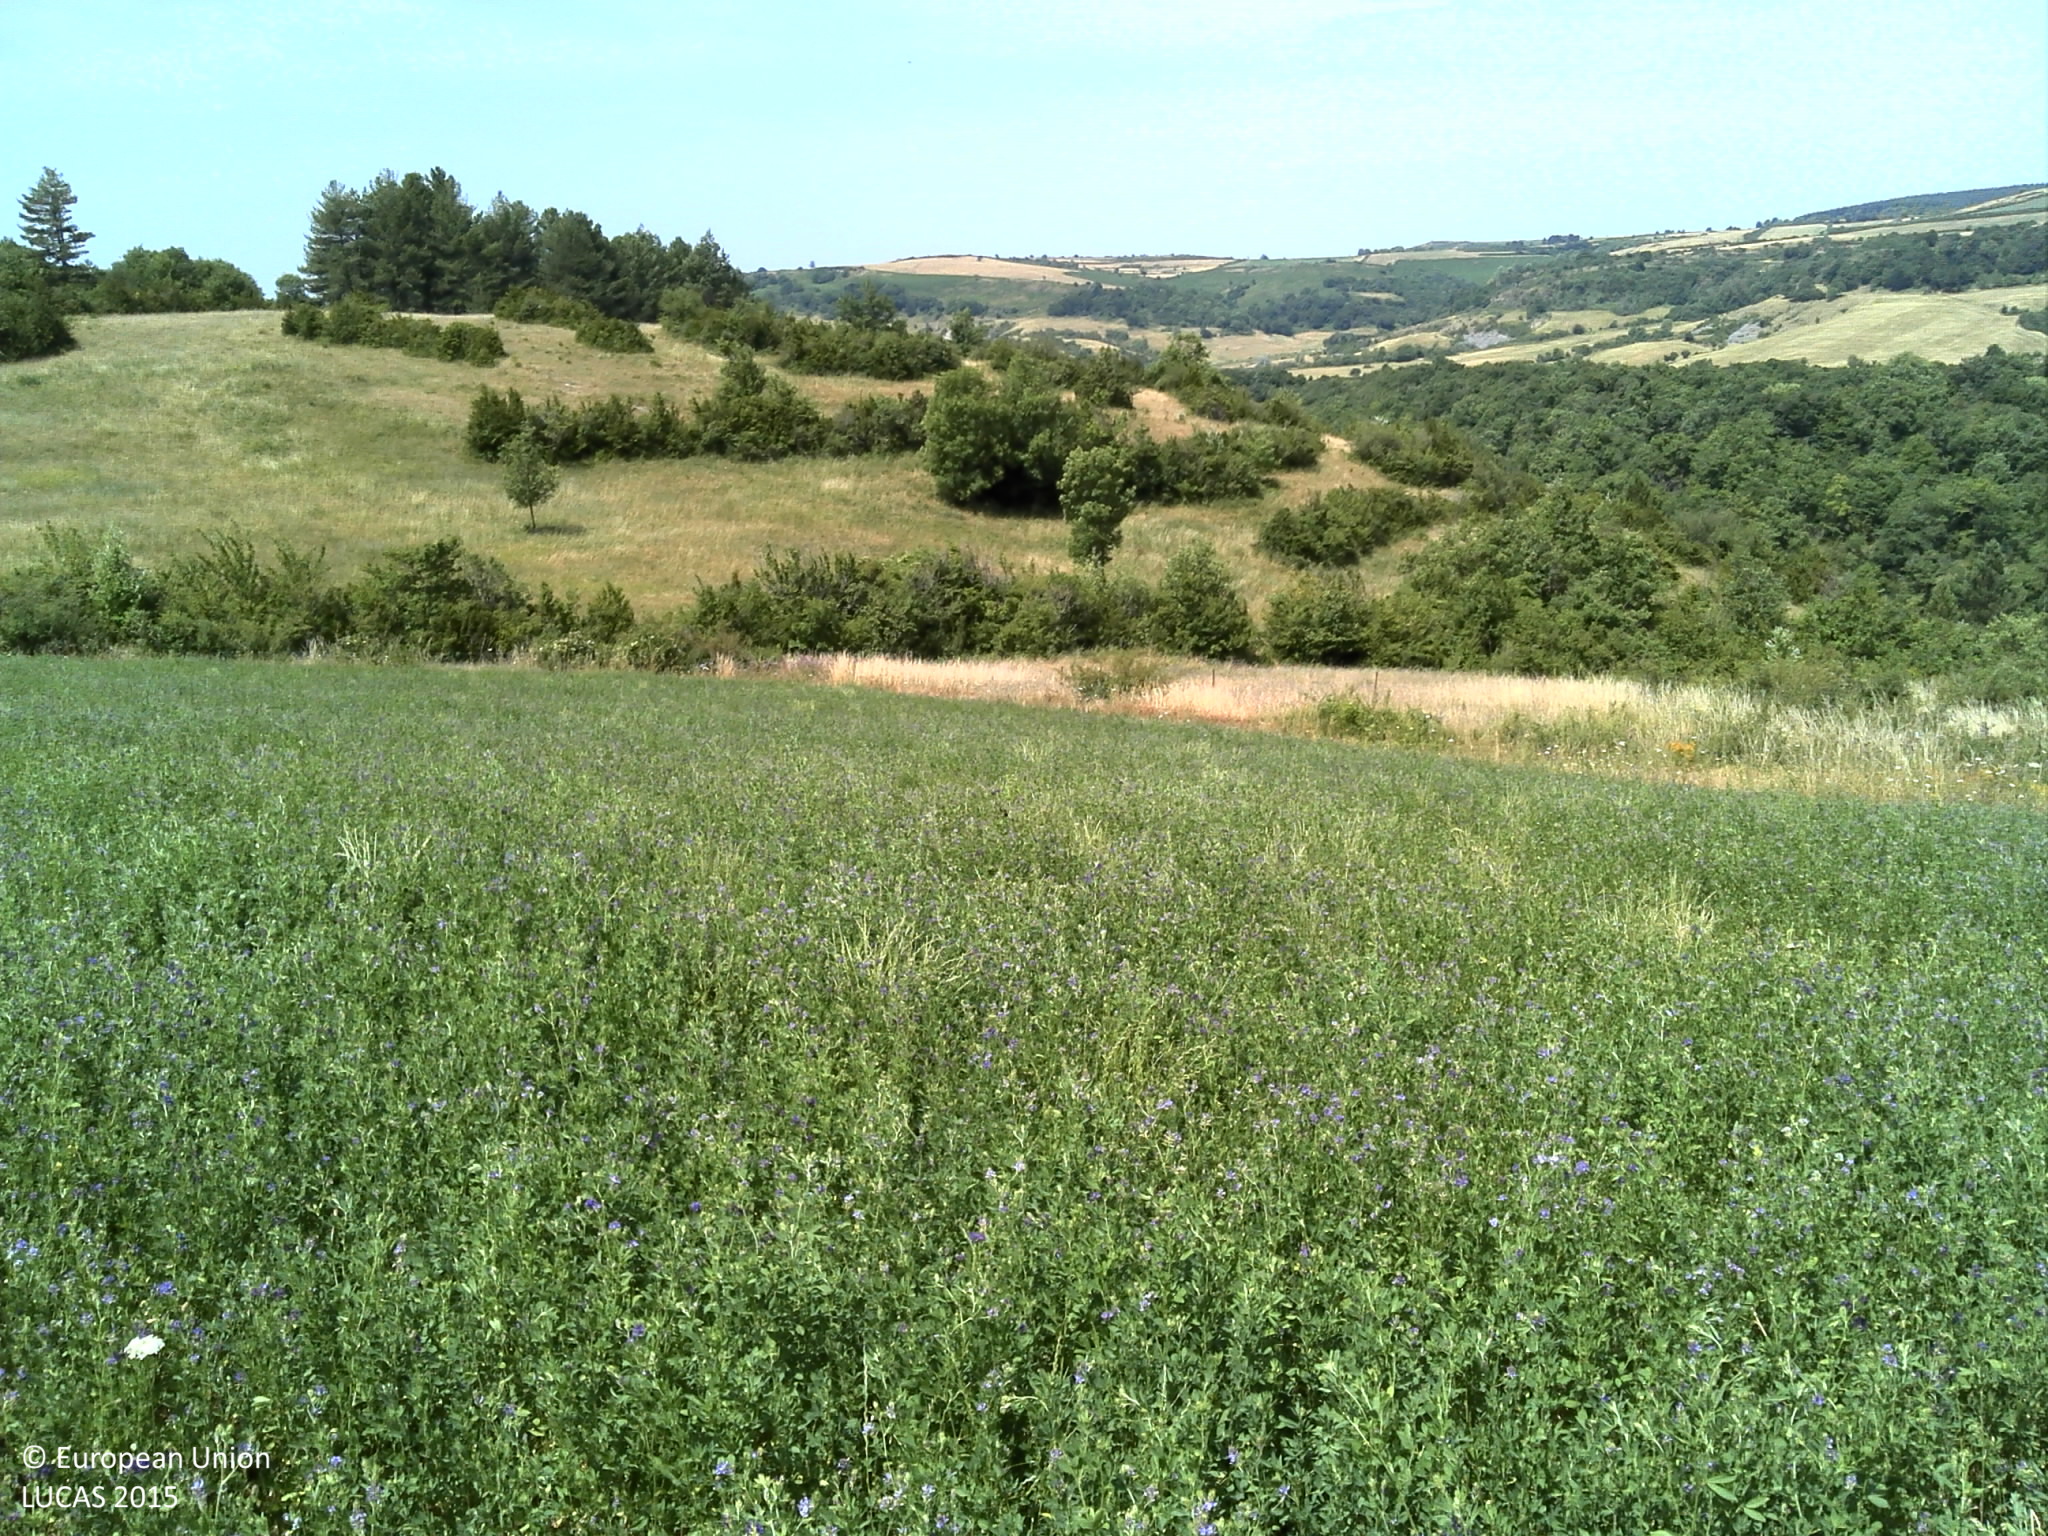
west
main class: Cropland
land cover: Lucerne
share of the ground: > 75 %
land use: Agriculture (excluding fallow land and kitchen gardens)
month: July
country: FR
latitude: 43.8250
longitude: 3.2805
